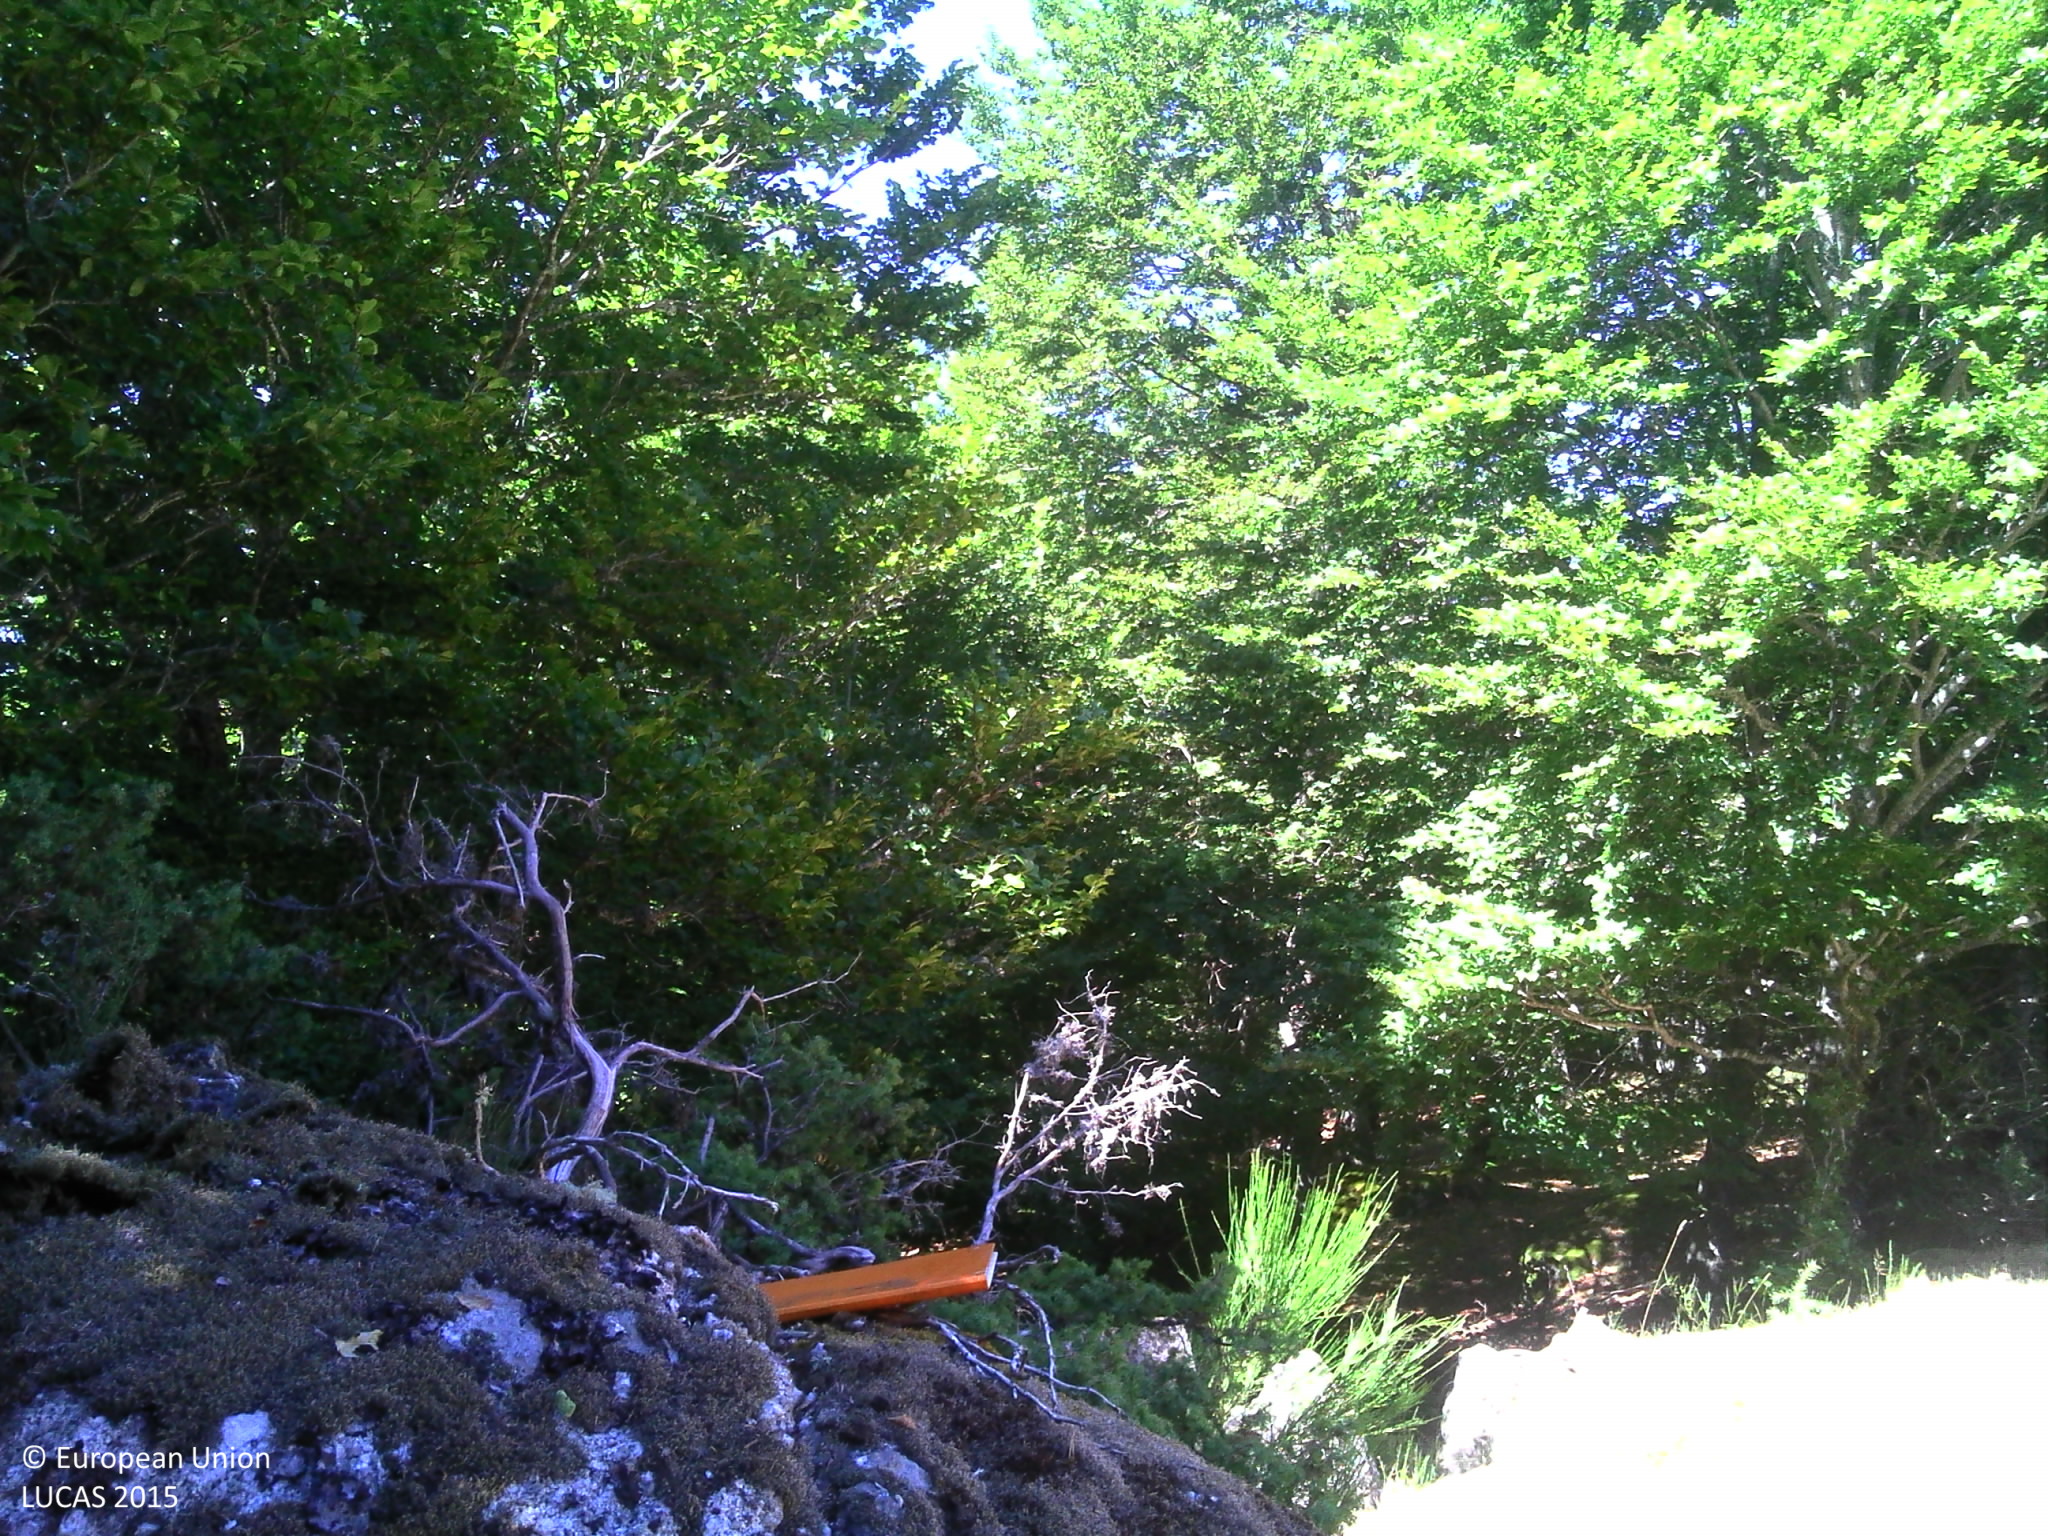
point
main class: Grassland
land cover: Grassland without tree/shrub cover
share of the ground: > 75 %
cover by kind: herbaceous plants 95 %, shrubs 5 %
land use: Agriculture (excluding fallow land and kitchen gardens)
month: July
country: FR
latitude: 44.7045
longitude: 3.4540
